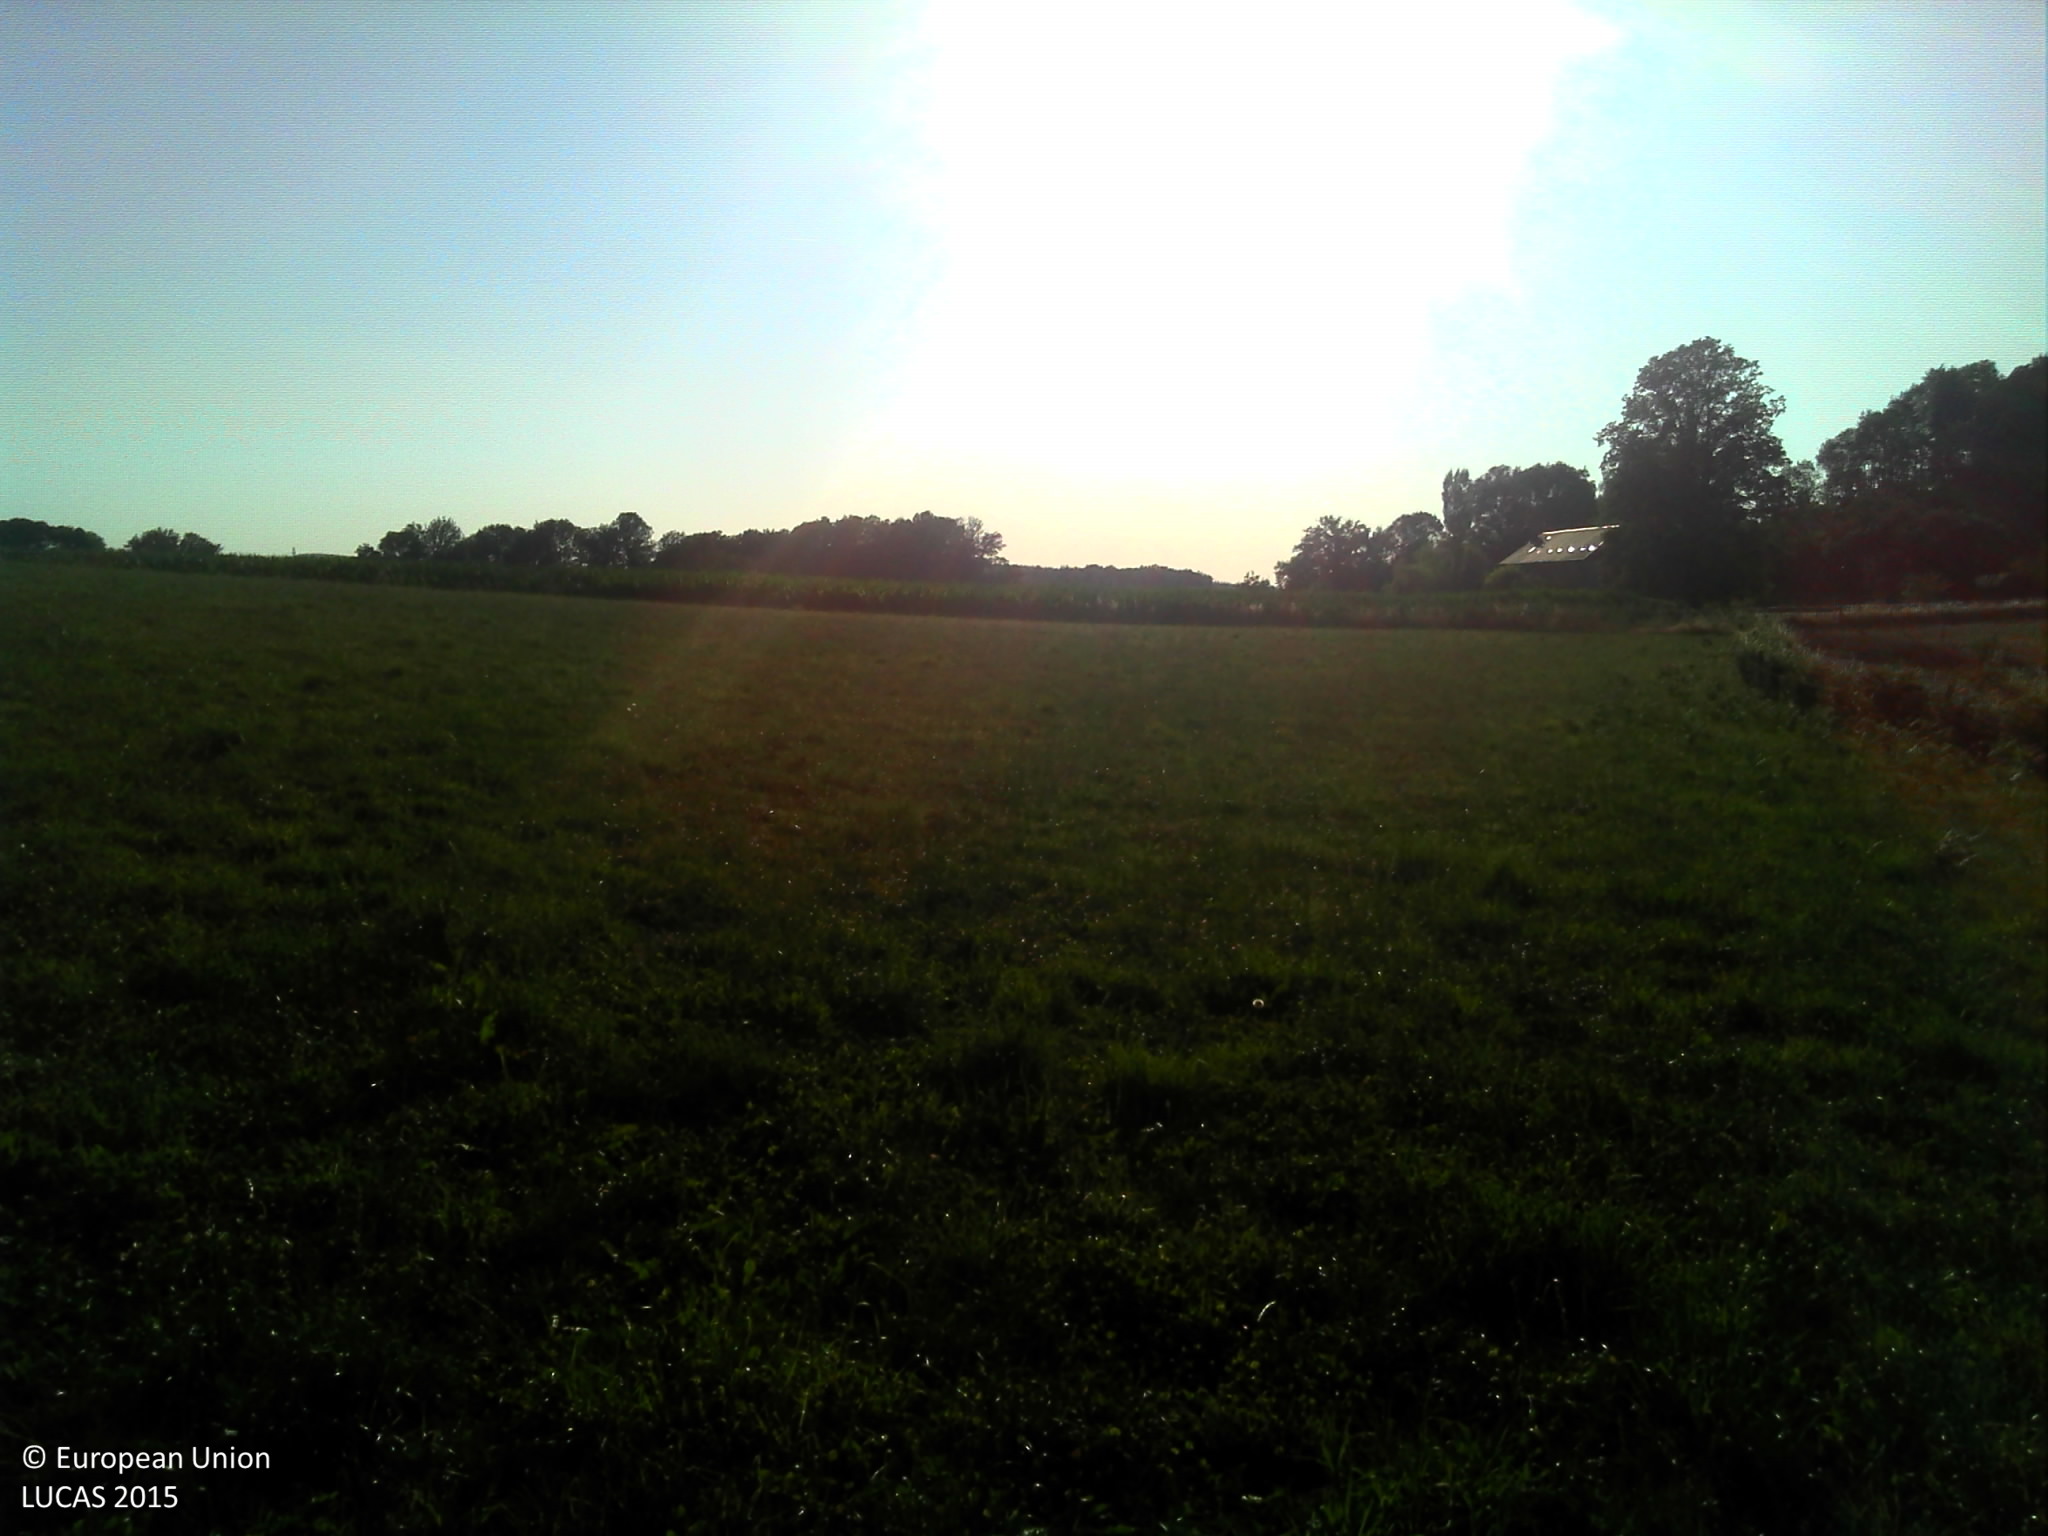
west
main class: Grassland
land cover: Grassland without tree/shrub cover
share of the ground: > 75 %
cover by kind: herbaceous plants 100 %
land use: Agriculture (excluding fallow land and kitchen gardens)
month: July
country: FR
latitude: 46.0629
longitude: 1.6803
